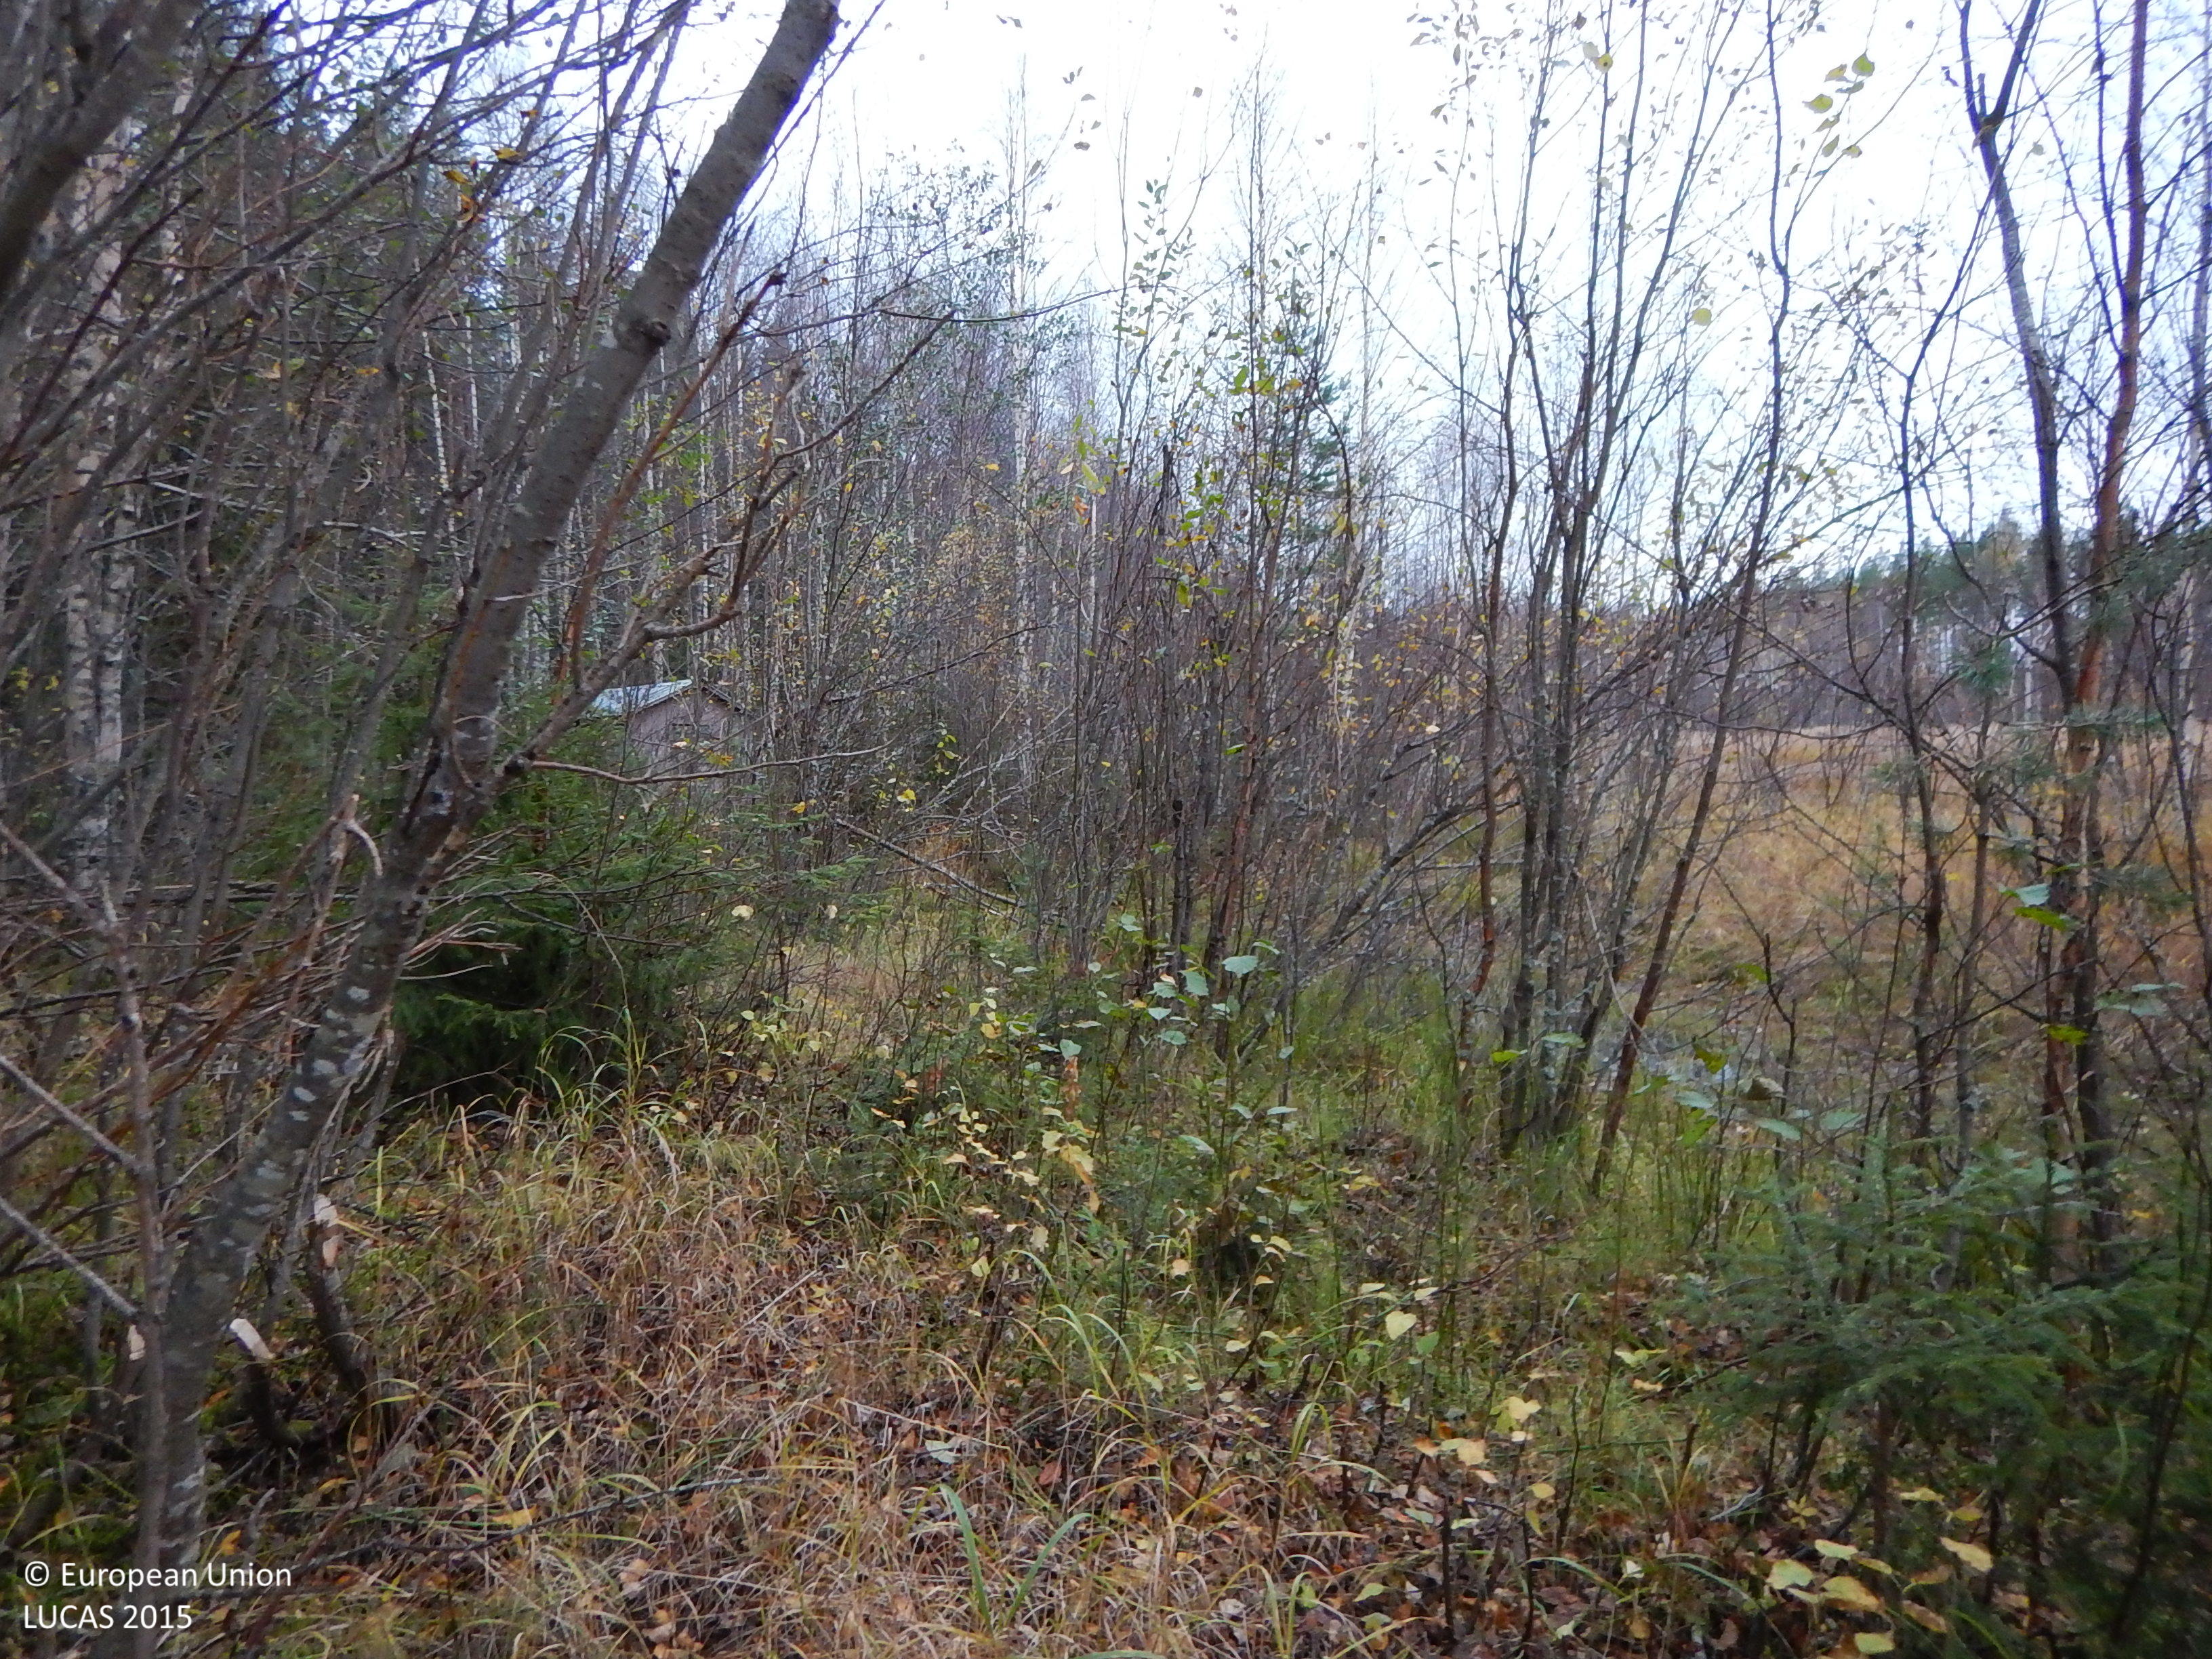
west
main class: Woodland
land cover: Broadleaved woodland
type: non-riverine alder, birch or aspen forest
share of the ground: 50 - 75 %
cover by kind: broadleaved forest trees 55 %, shrubs 20 %, herbaceous plants 10 %, lichens and mosses 10 %, coniferous forest trees 5 %
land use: Semi-natural and natural areas not in use
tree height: > 5 m
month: October
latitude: 64.8548
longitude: 21.0086
